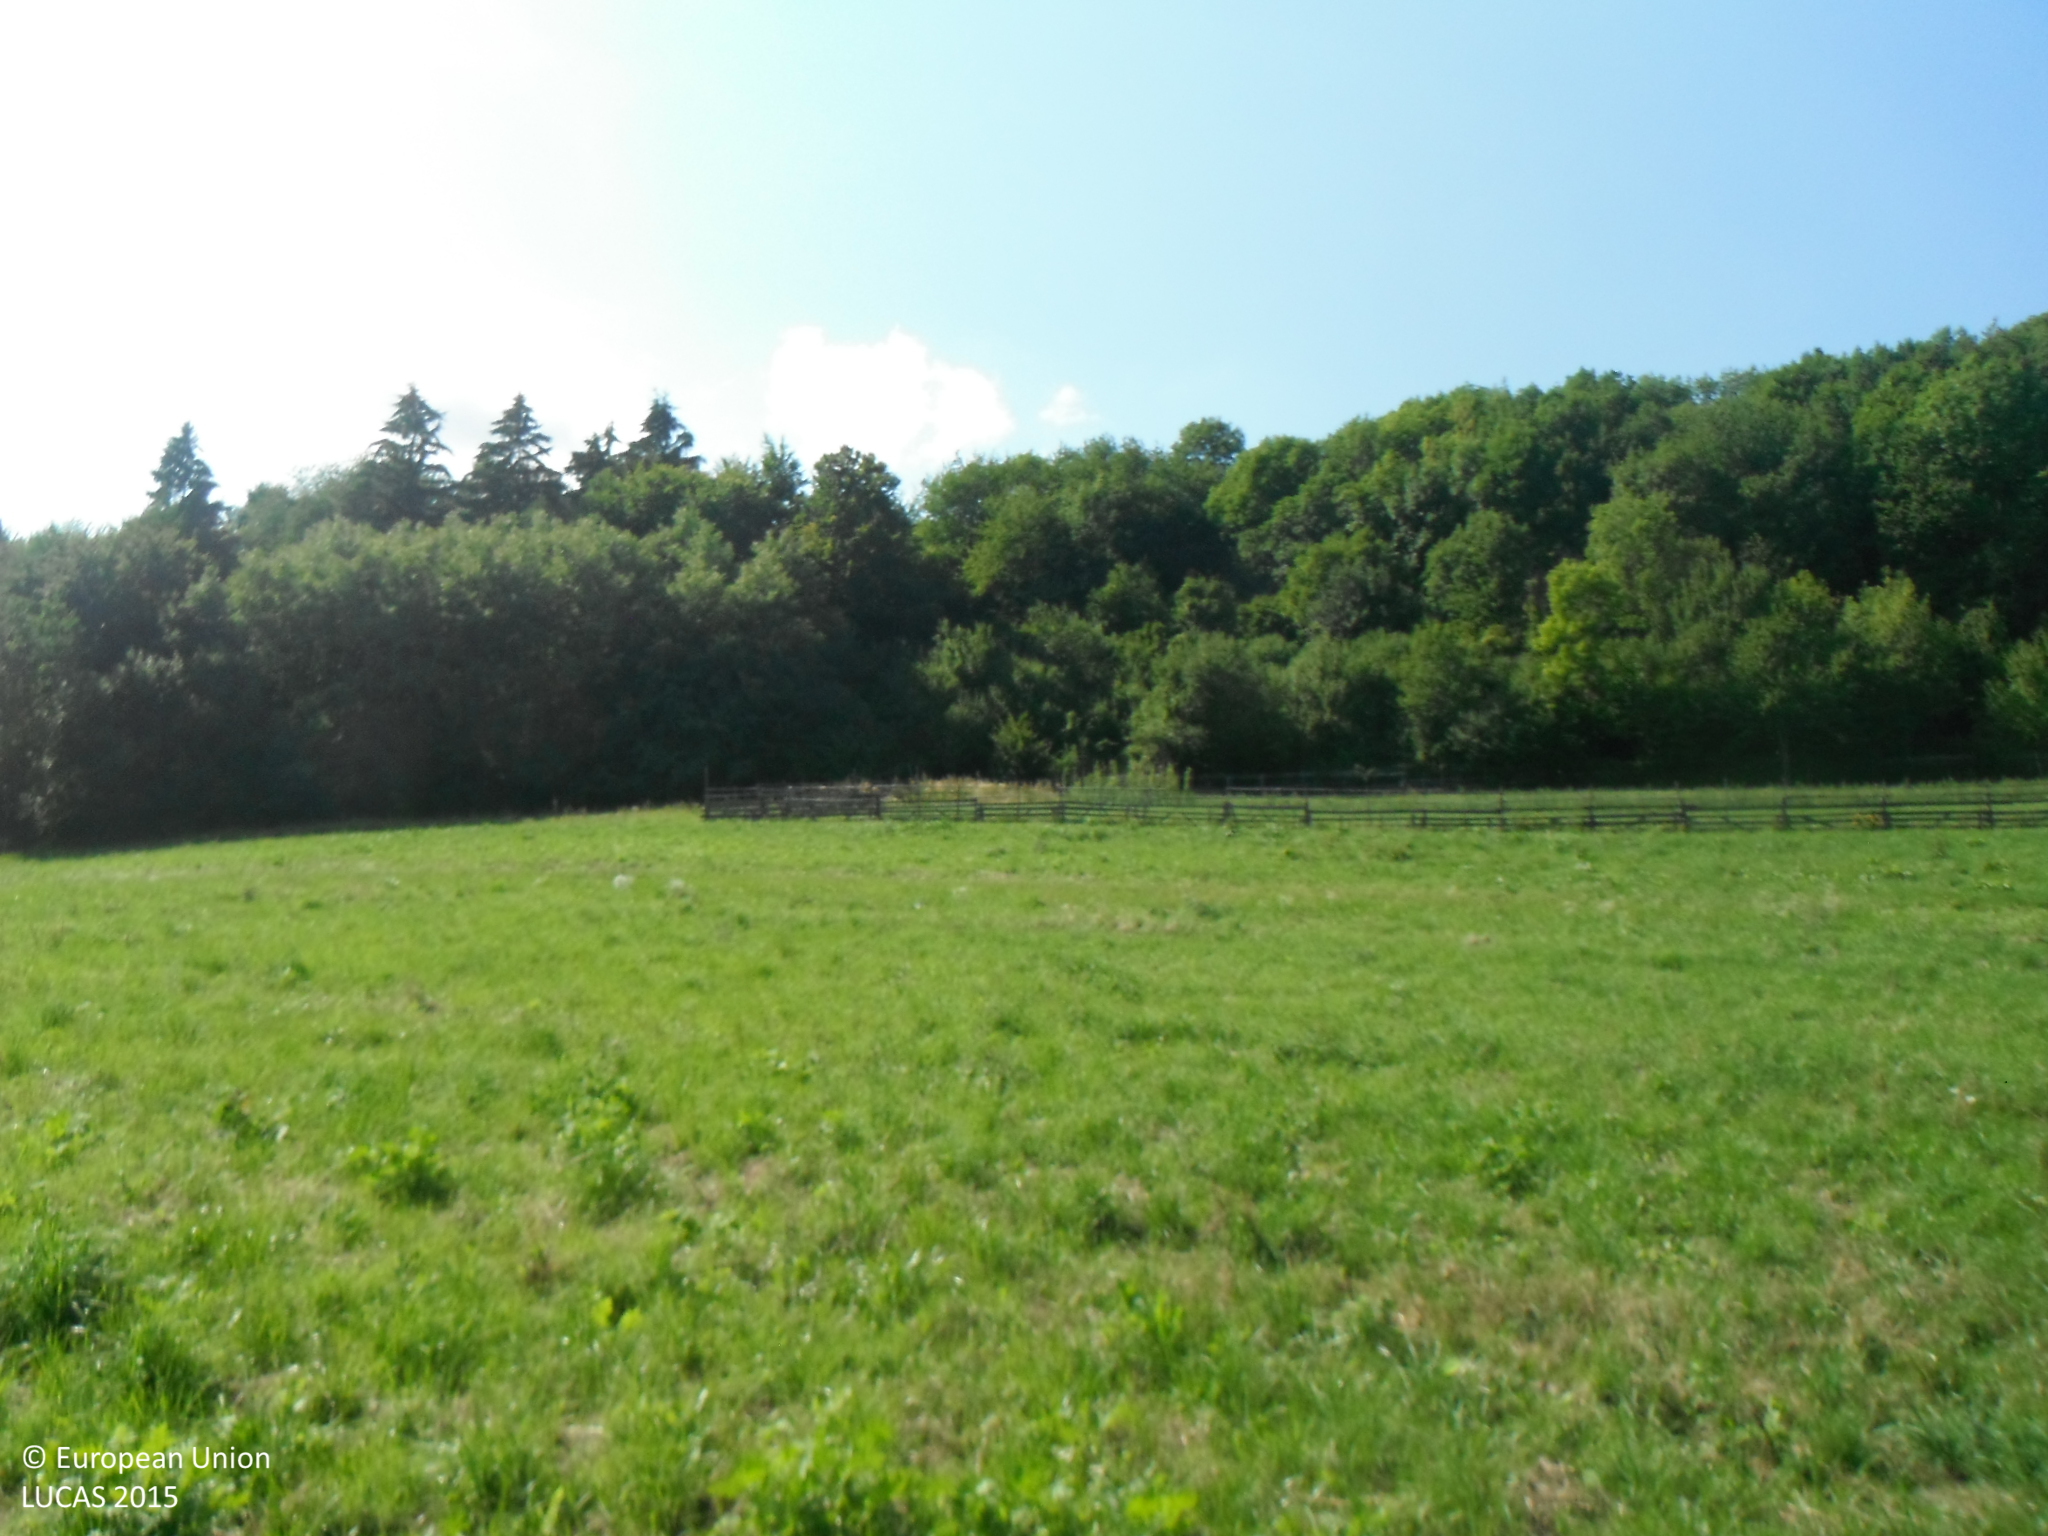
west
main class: Grassland
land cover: Grassland without tree/shrub cover
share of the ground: > 75 %
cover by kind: herbaceous plants 100 %
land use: Agriculture (excluding fallow land and kitchen gardens)
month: August
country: SK
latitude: 49.0600
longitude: 18.1583
